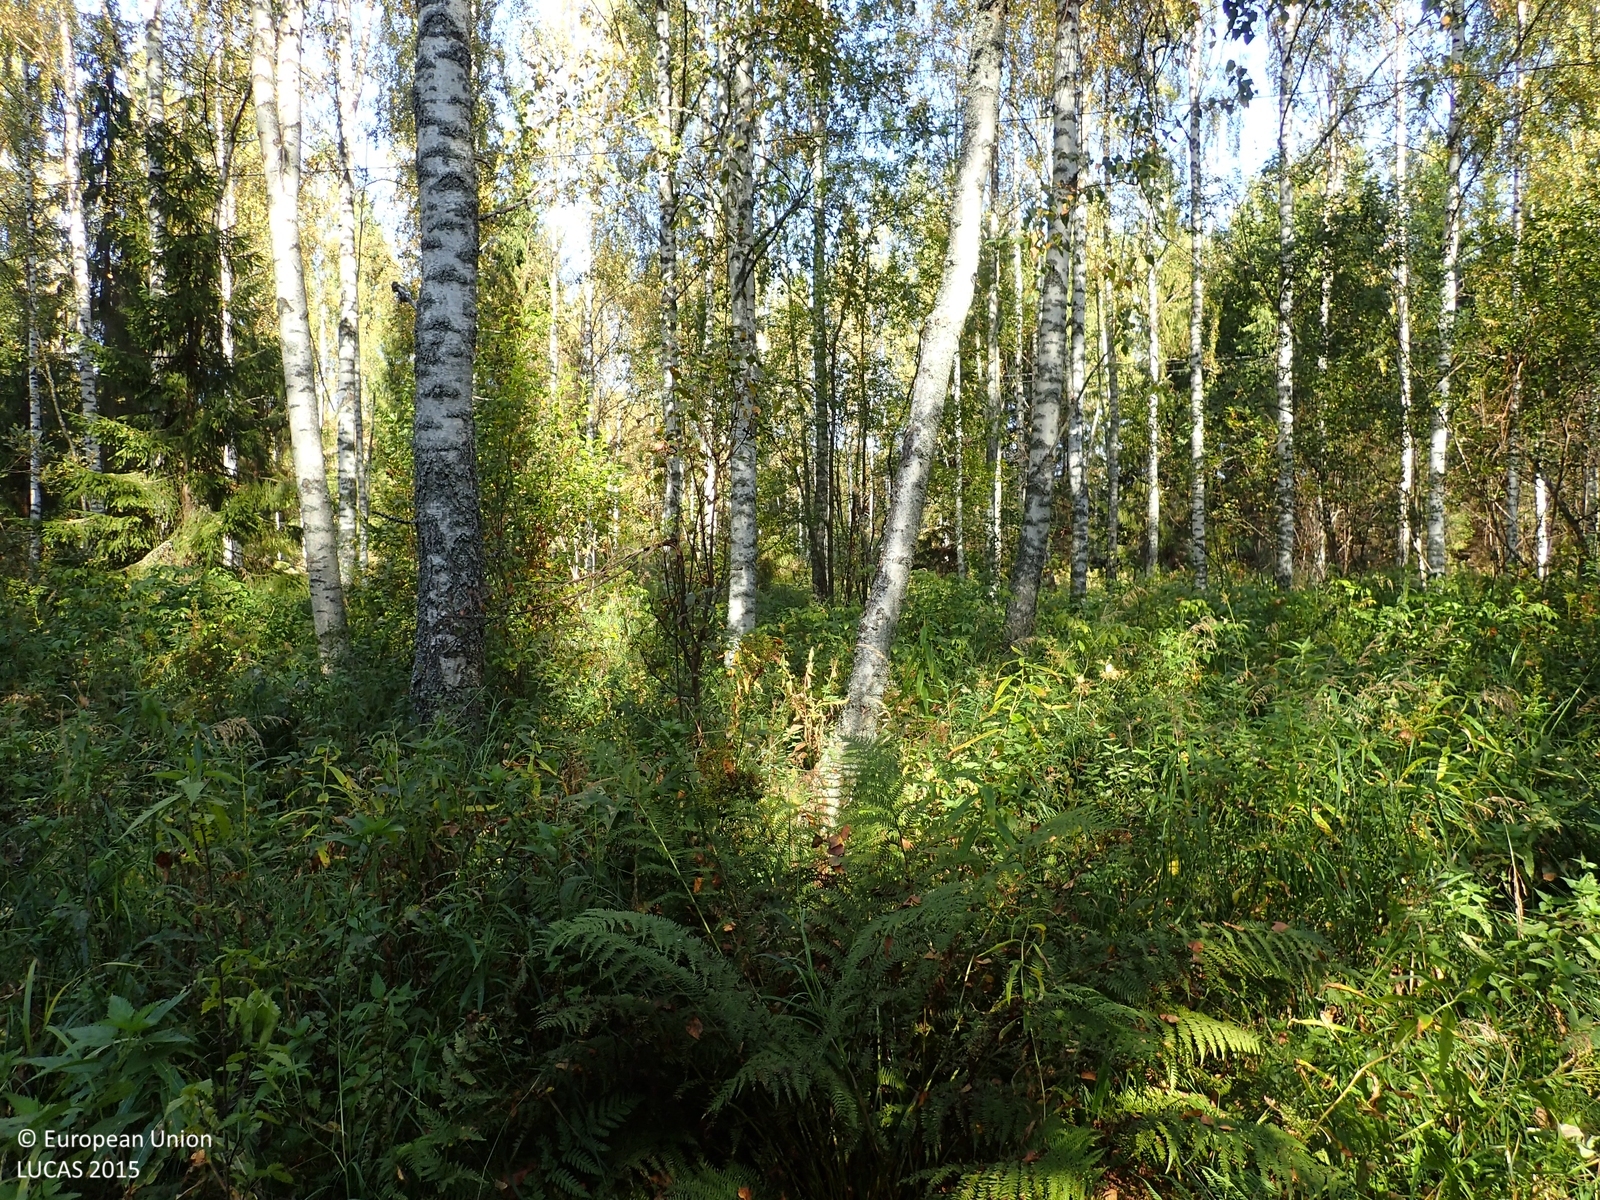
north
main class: Woodland
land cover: Broadleaved woodland
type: non-riverine alder, birch or aspen forest
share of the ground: 50 - 75 %
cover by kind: broadleaved forest trees 70 %, herbaceous plants 30 %
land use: Forestry
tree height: > 5 m
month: September
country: FI
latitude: 63.1915
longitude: 25.6293
